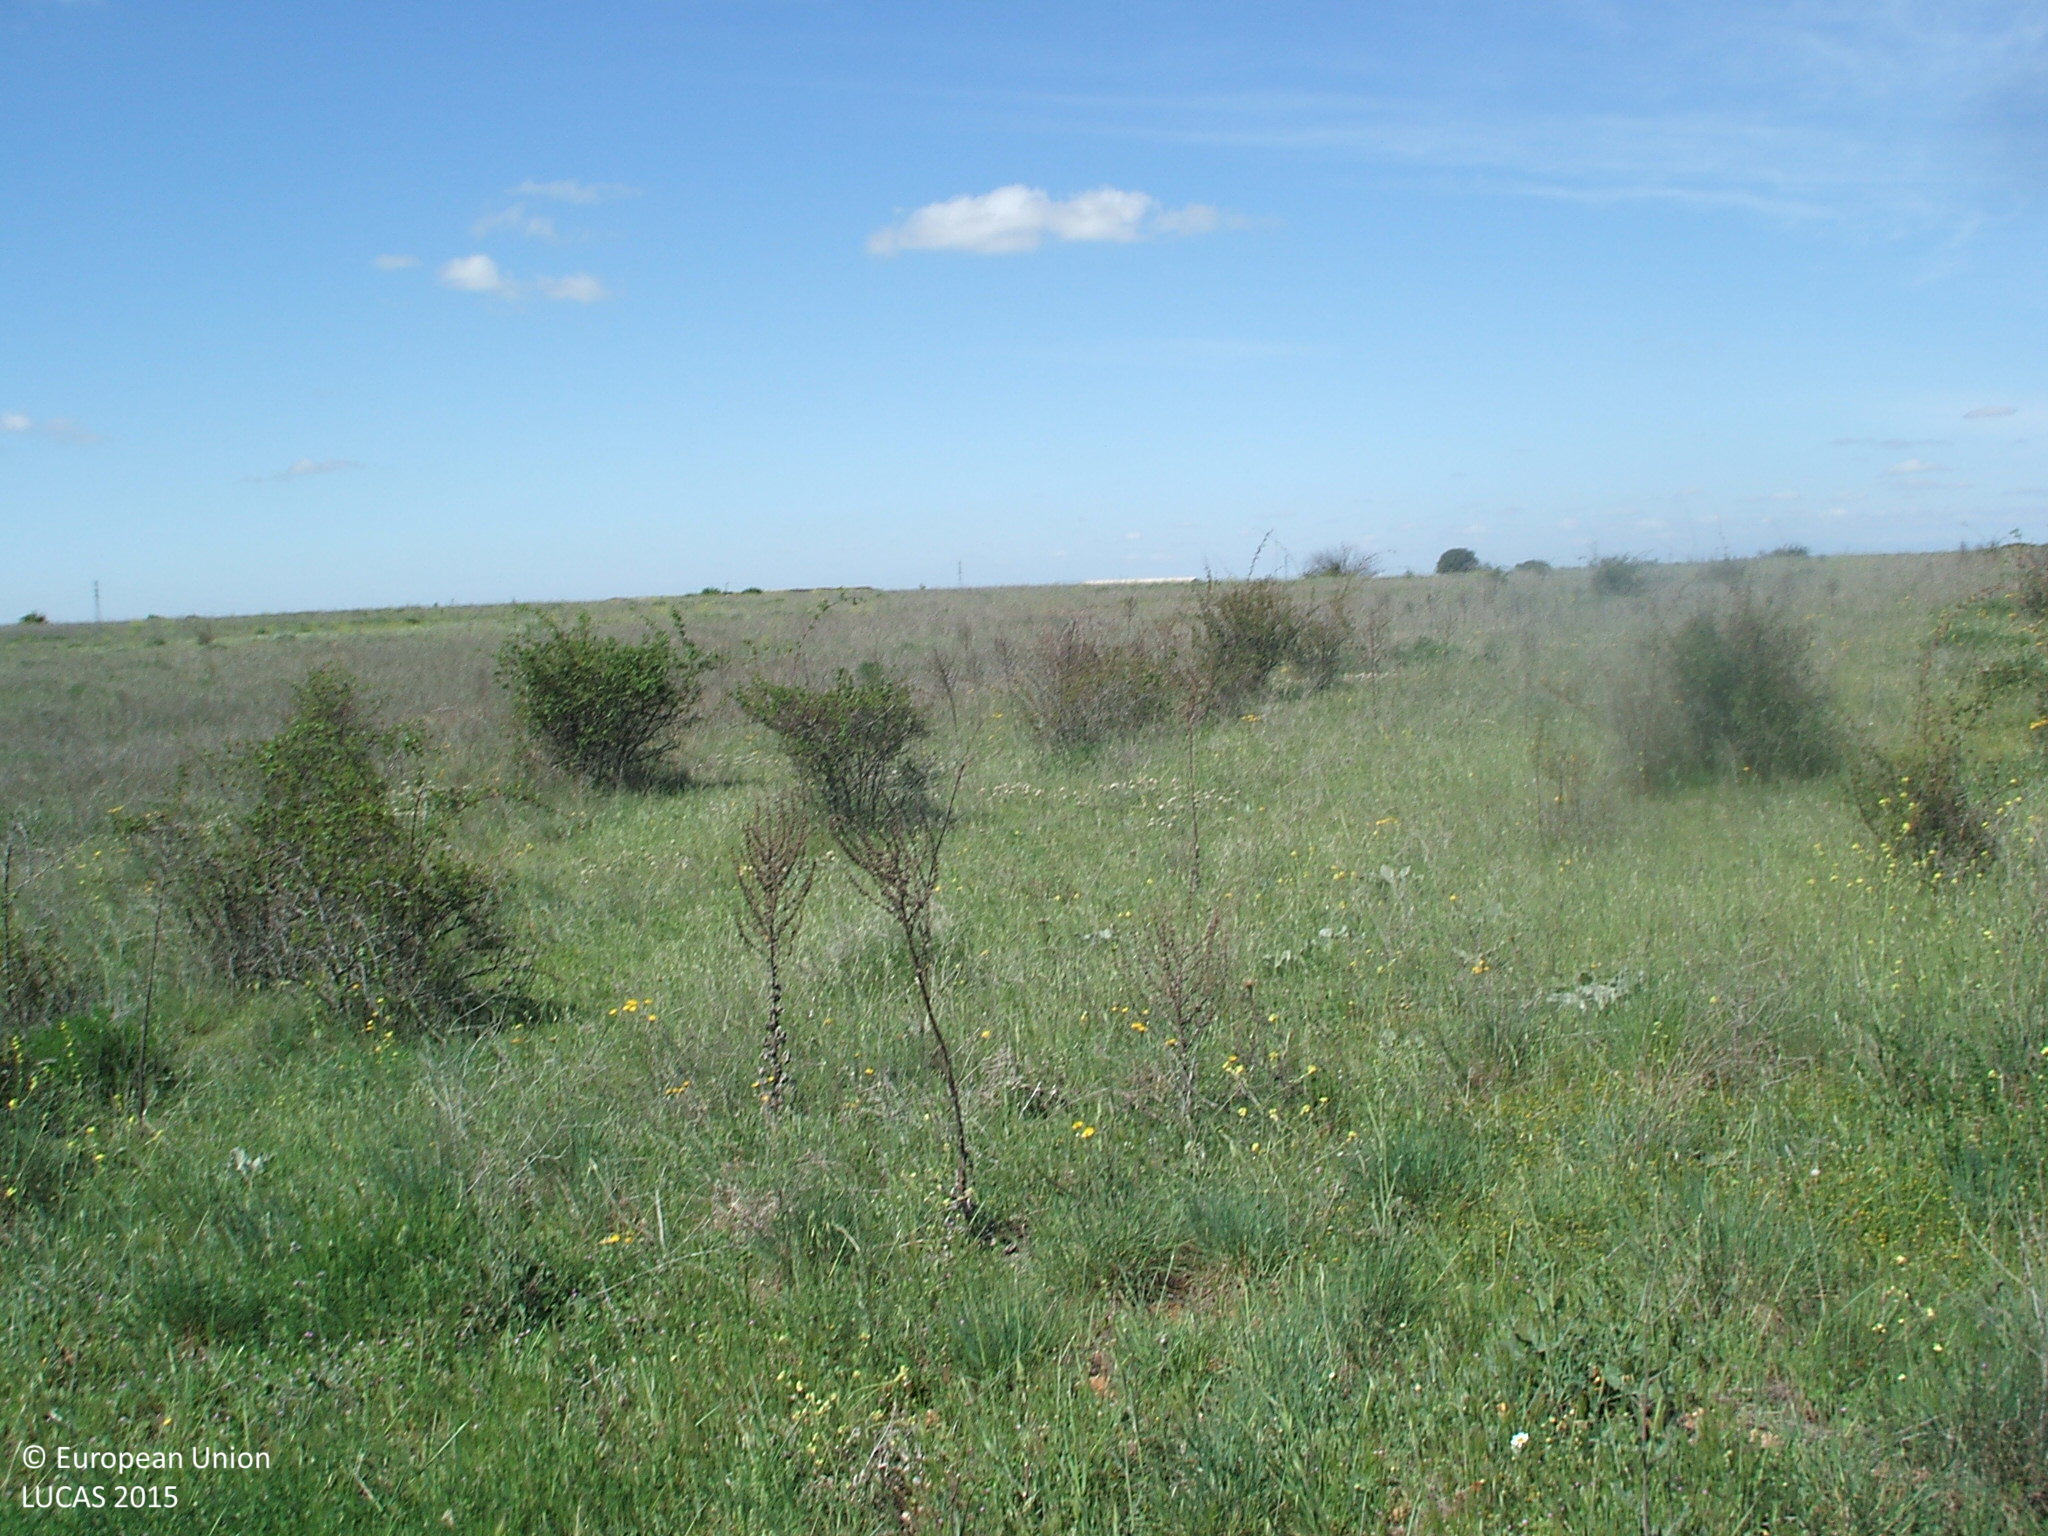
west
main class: Grassland
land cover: Spontaneously vegetated surfaces
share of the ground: > 75 %
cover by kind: herbaceous plants 95 %, shrubs 5 %
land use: Fallow land
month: May
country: ES
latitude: 40.7550
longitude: -2.9789
